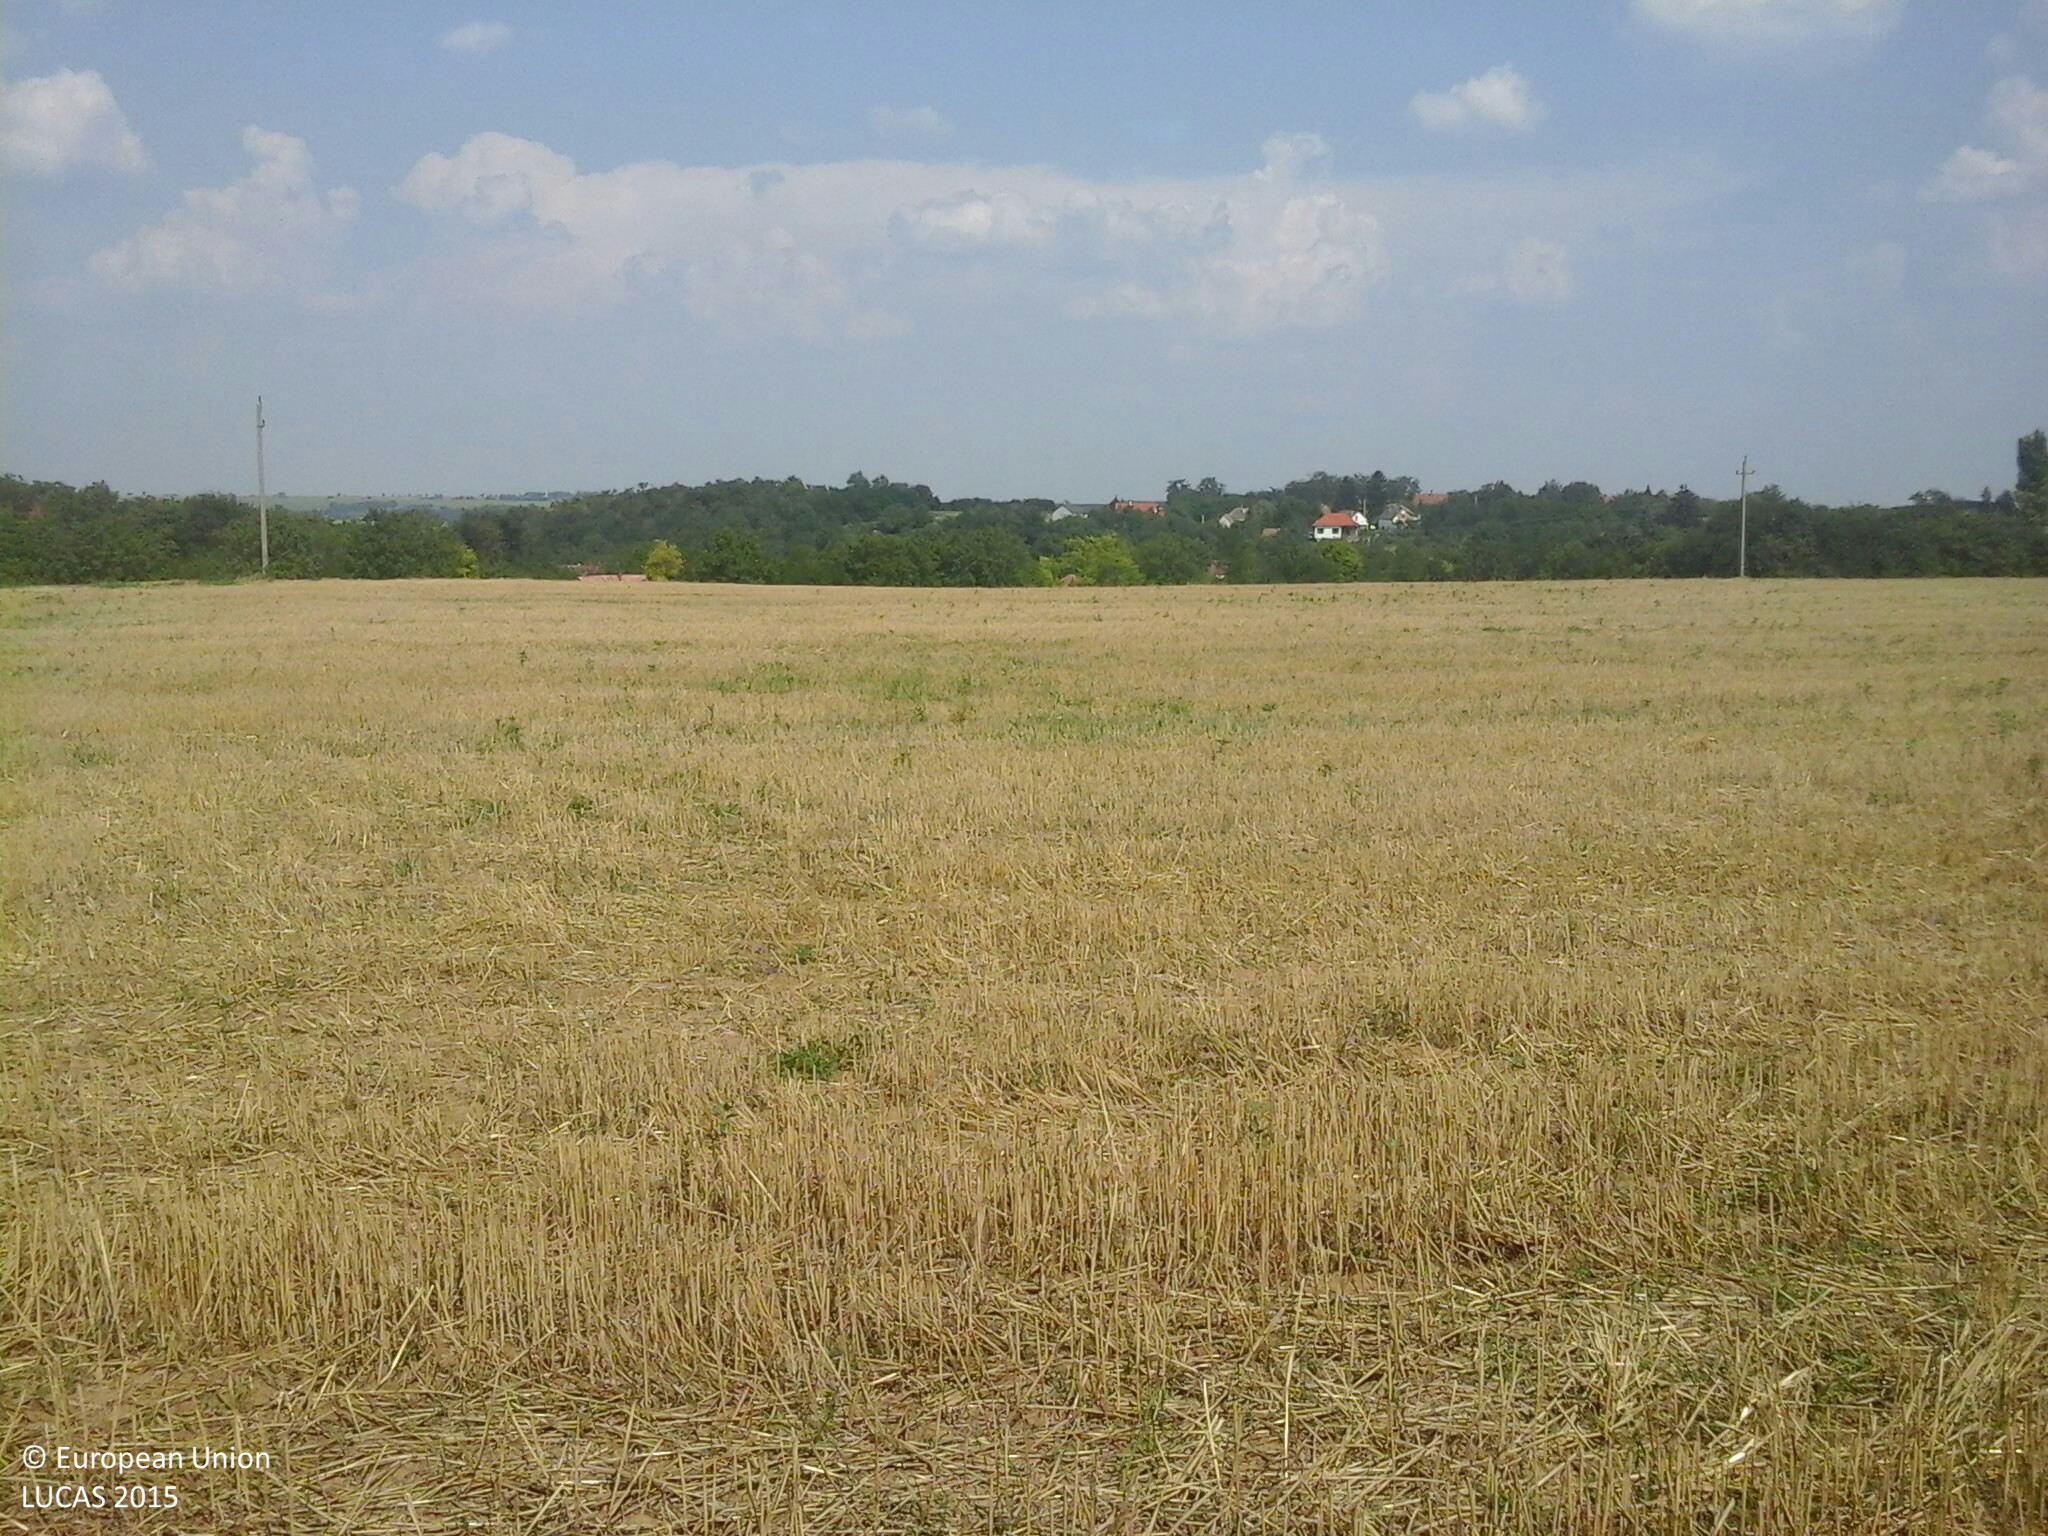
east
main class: Cropland
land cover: Common wheat
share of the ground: 10 - 25 %
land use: Agriculture (excluding fallow land and kitchen gardens)
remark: Harvested field
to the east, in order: Lines of trees; Common wheat; Electric lines; Common wheat
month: August
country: HU
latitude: 45.9774
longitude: 18.2546
